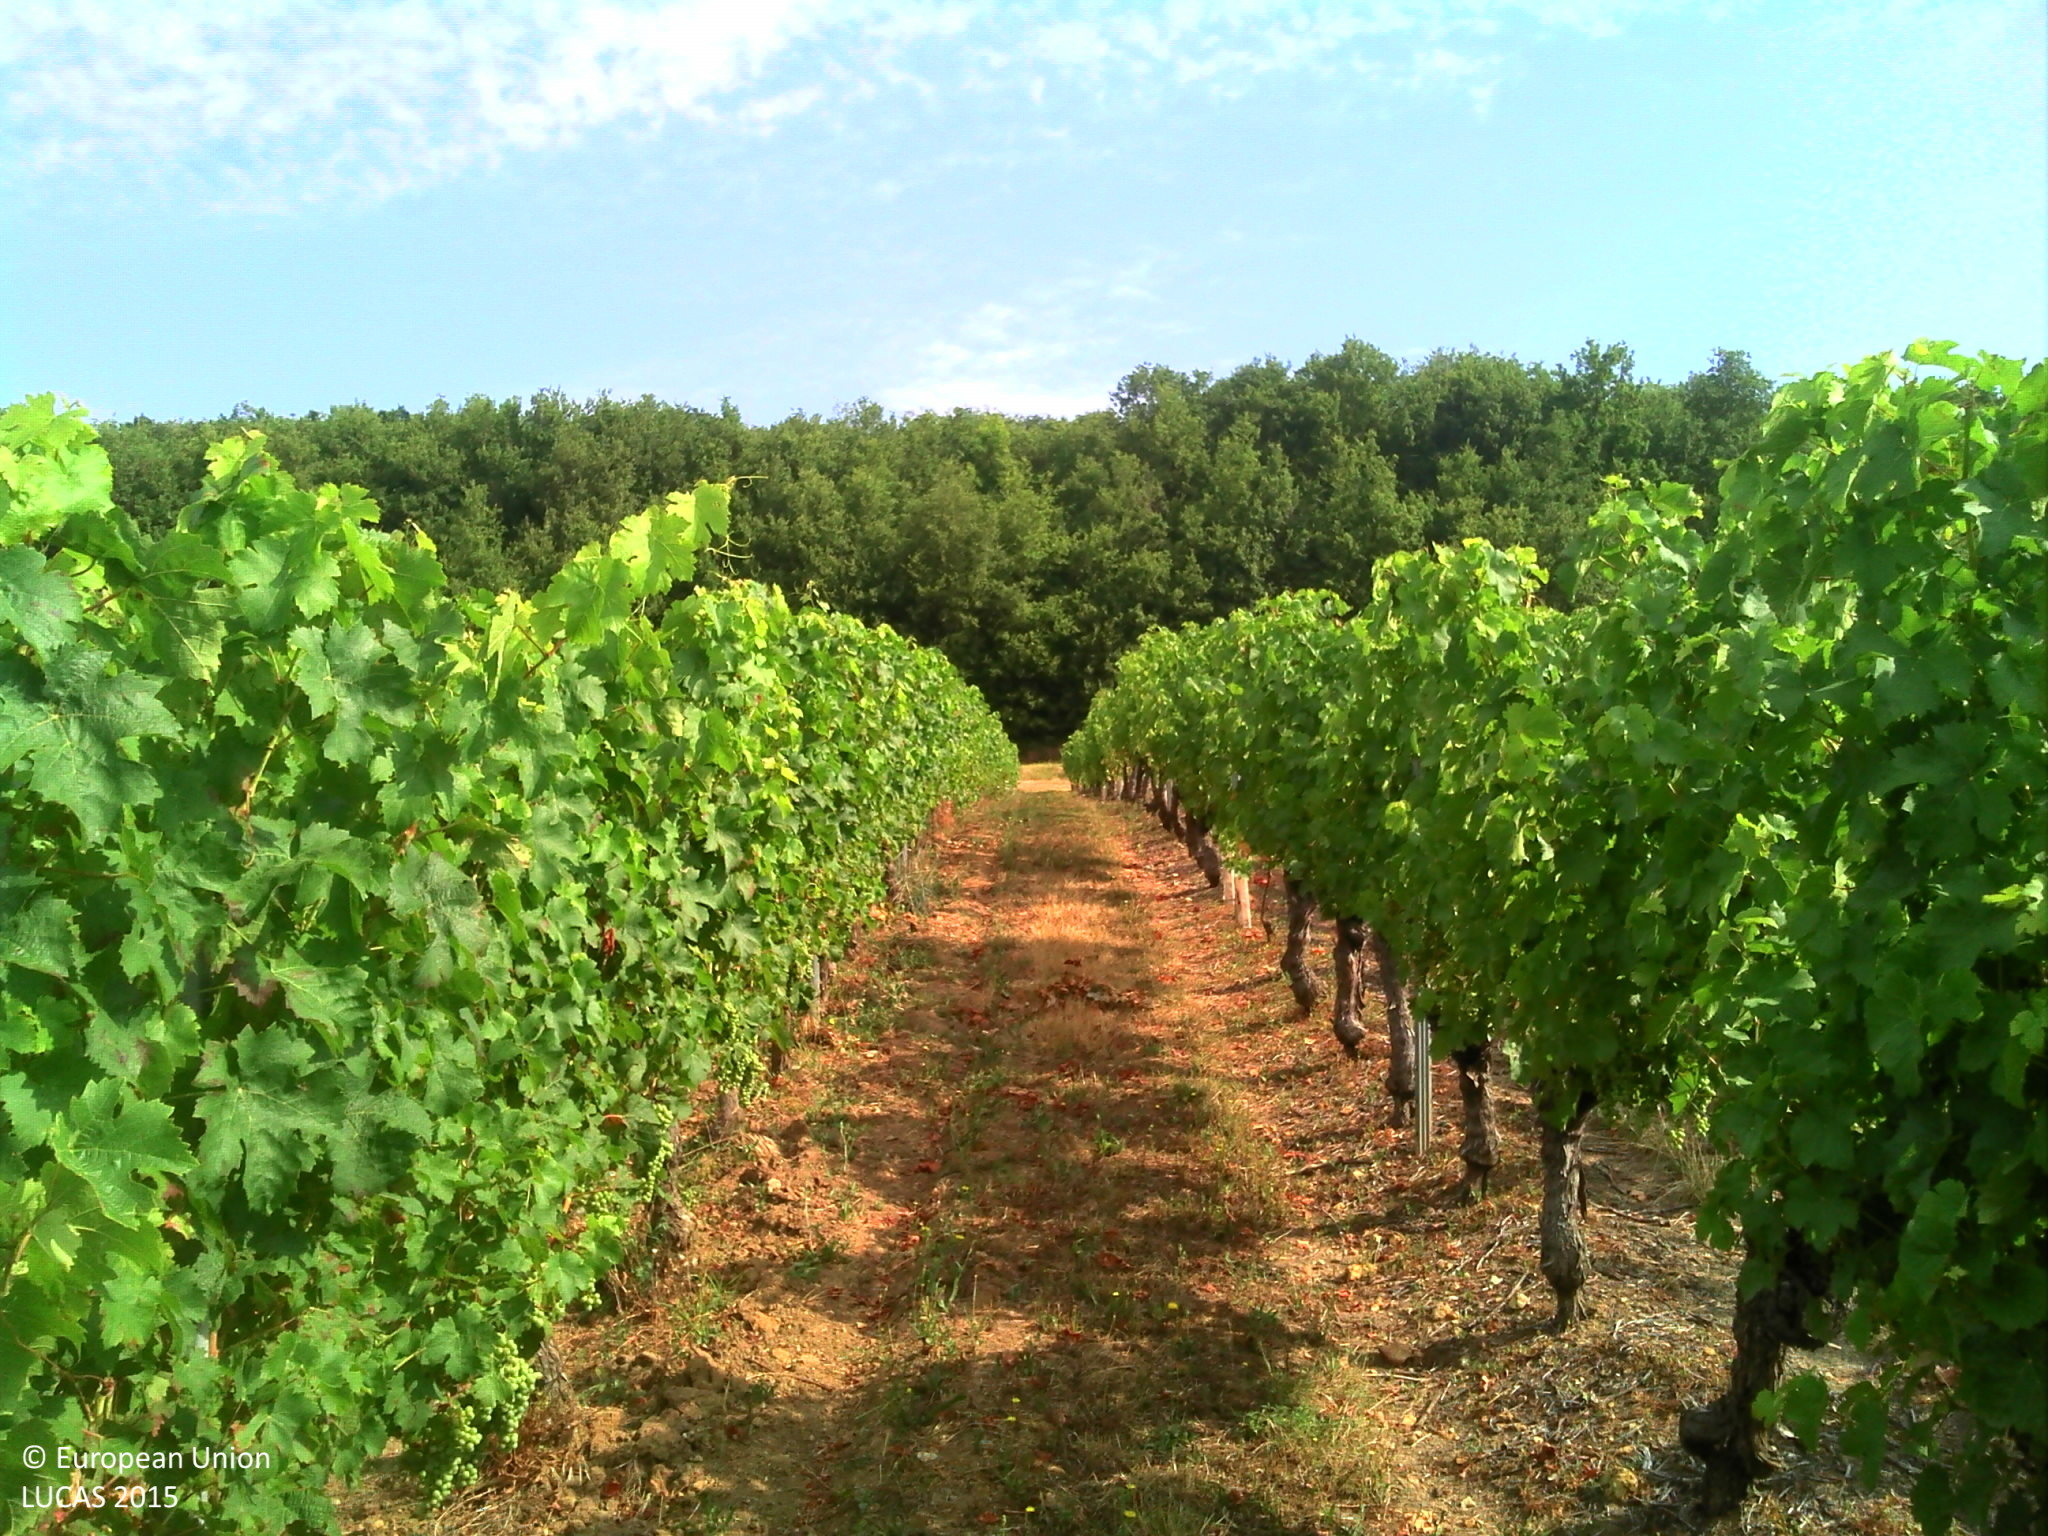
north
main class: Cropland
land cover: Vineyards
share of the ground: 50 - 75 %
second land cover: Grassland without tree/shrub cover
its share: 50 - 75 %
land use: Agriculture (excluding fallow land and kitchen gardens)
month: August
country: FR
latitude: 47.1505
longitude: 0.3912
